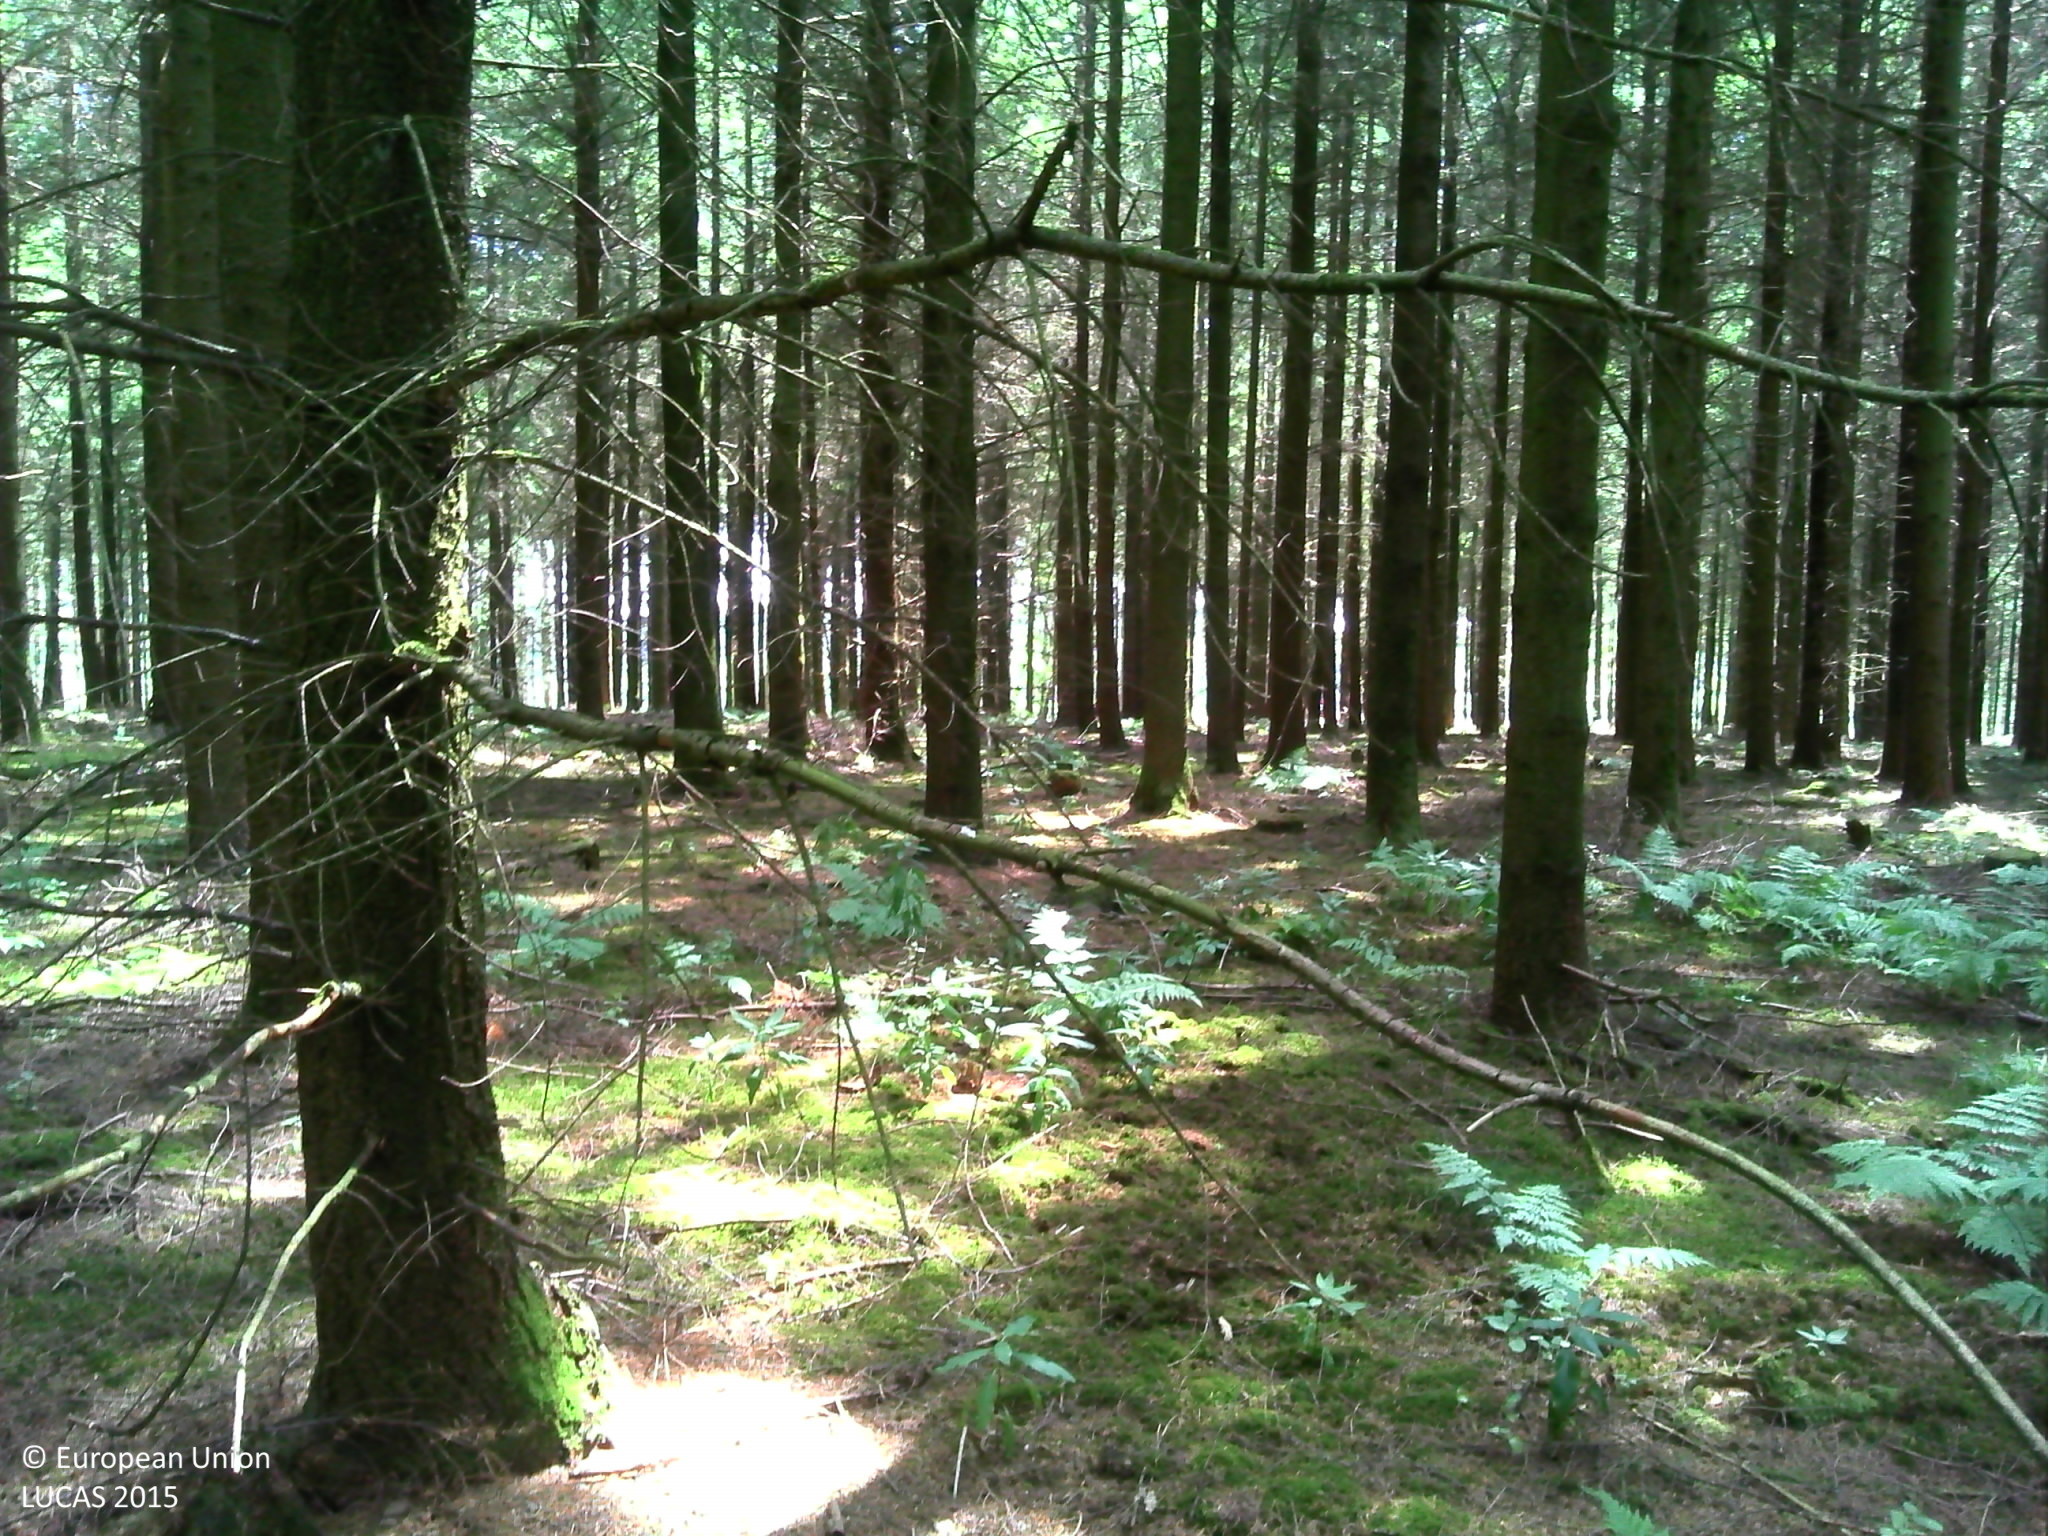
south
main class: Woodland
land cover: Other coniferous woodland
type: exotic forest
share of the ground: > 75 %
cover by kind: coniferous forest trees 95 %, herbaceous plants 5 %
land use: Forestry
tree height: > 5 m
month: July
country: BE
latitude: 49.8880
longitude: 5.7257
